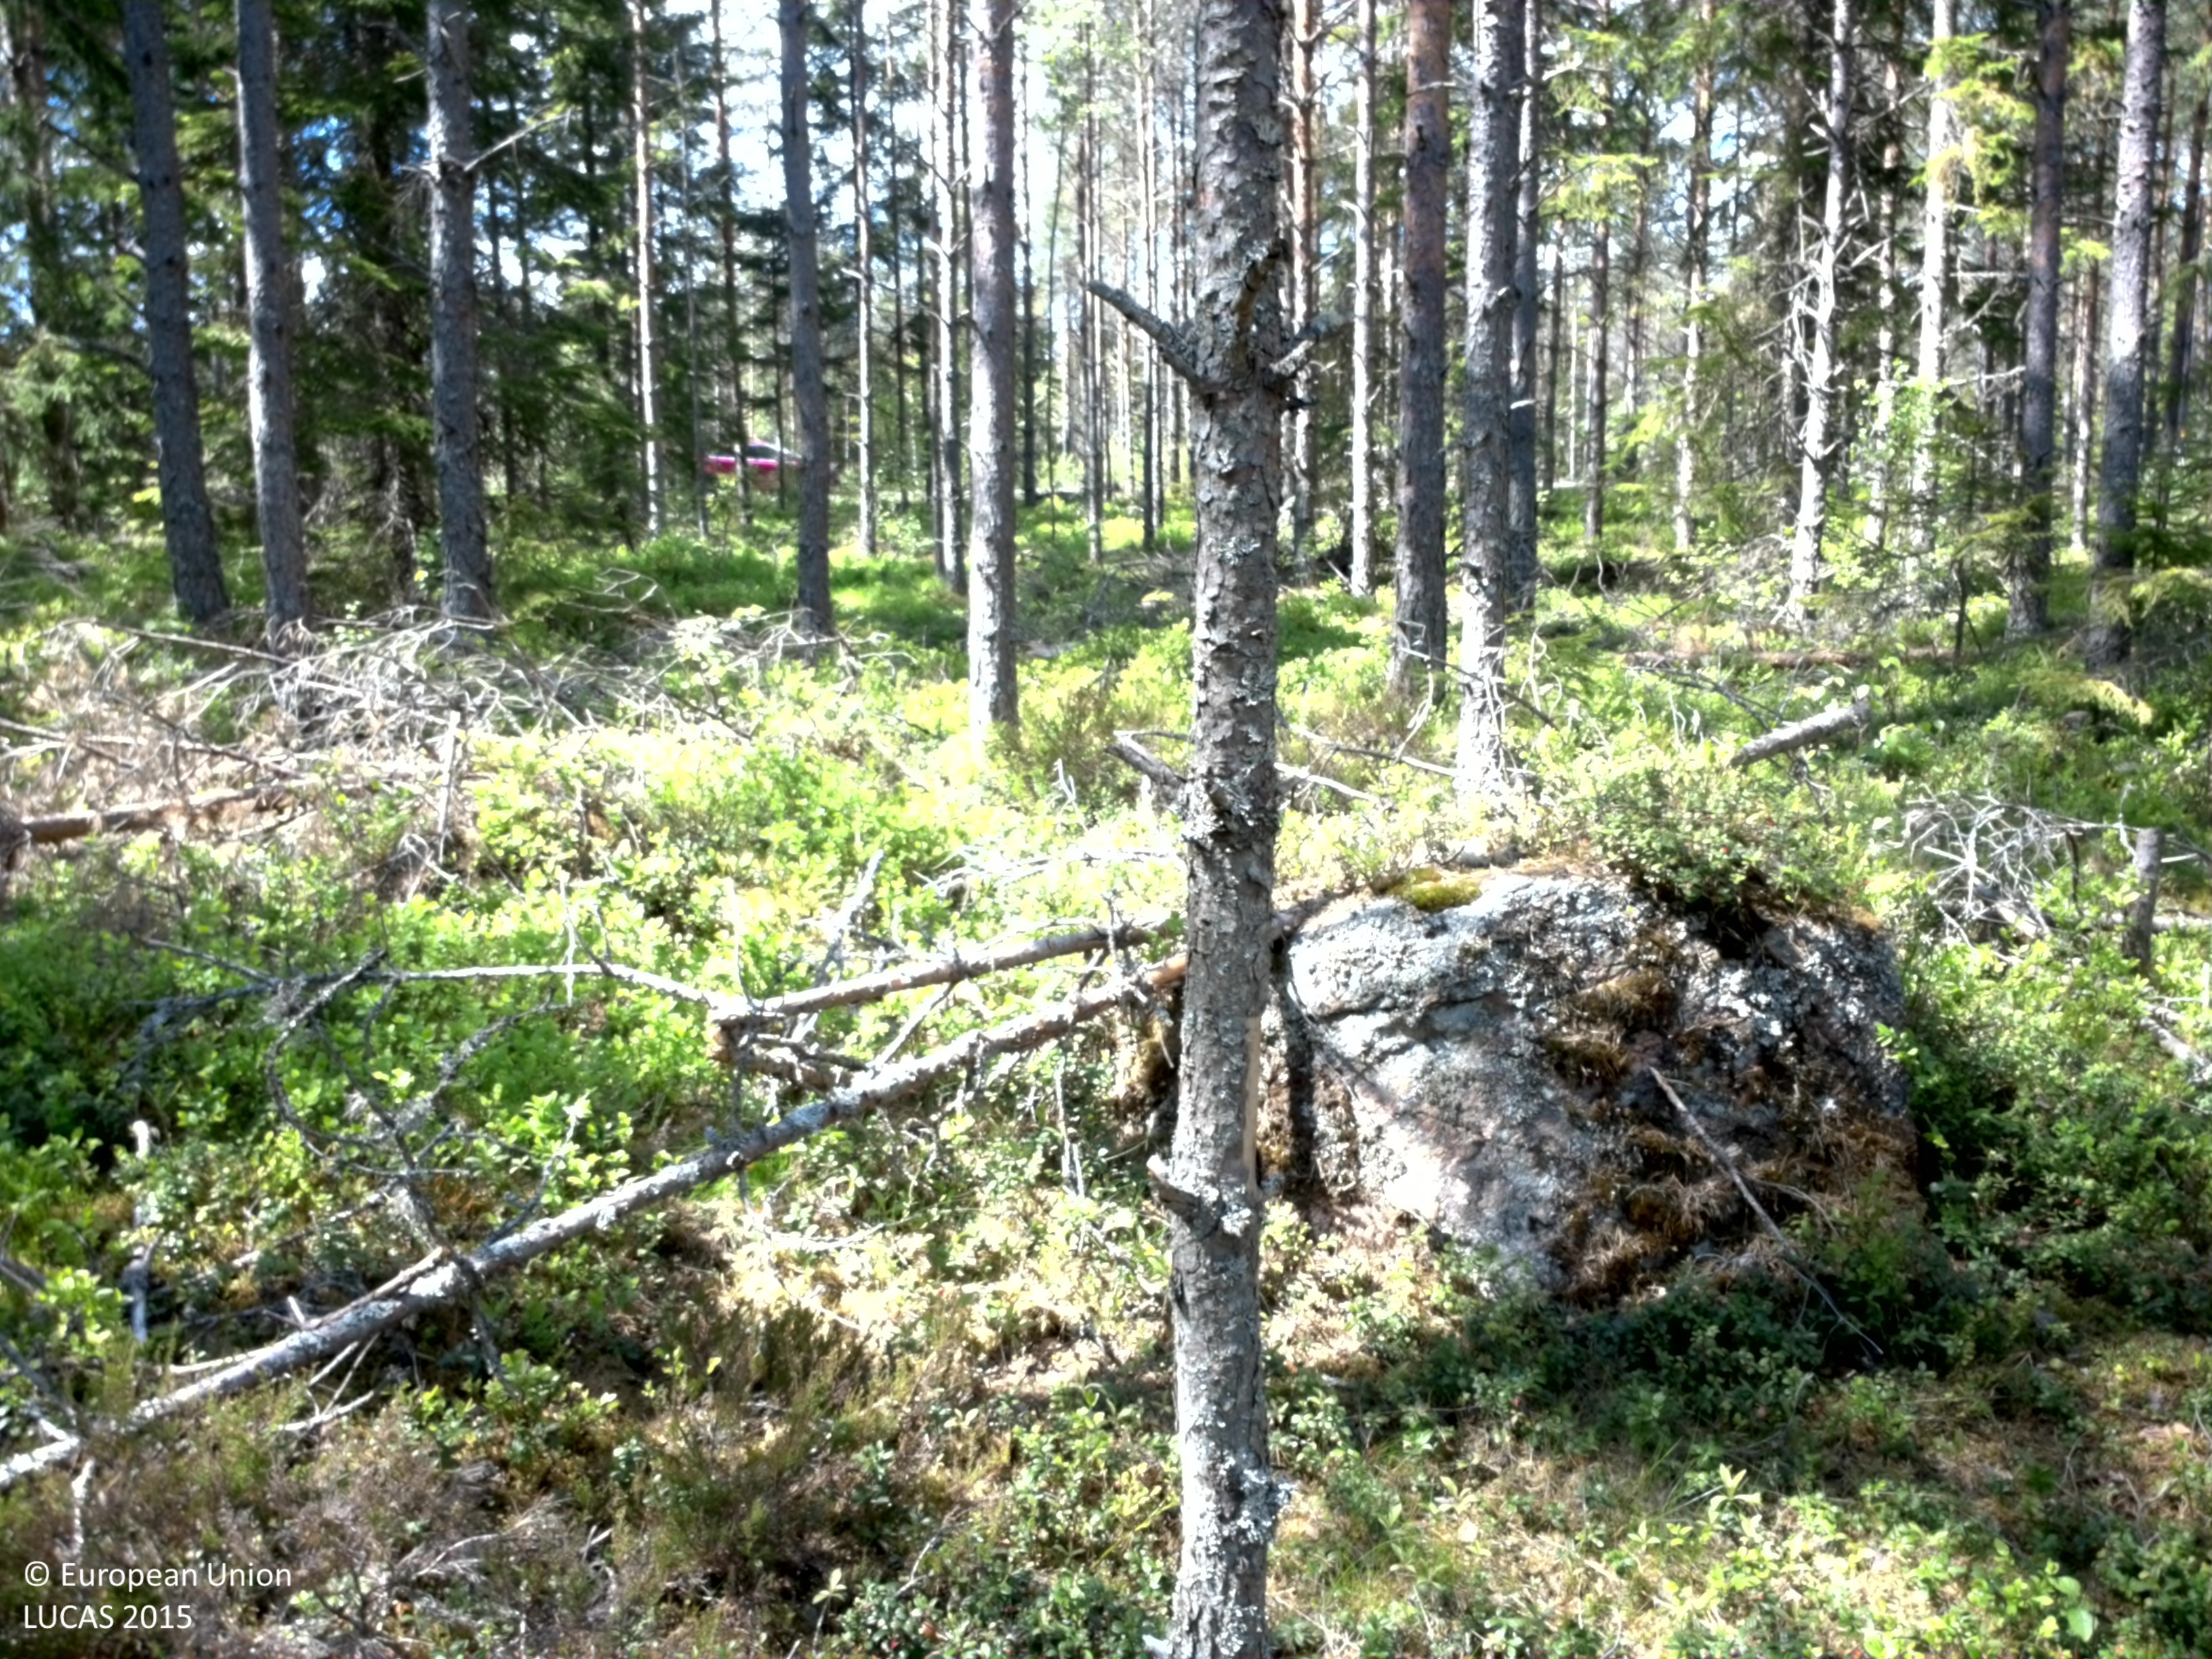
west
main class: Woodland
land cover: Pine dominated coniferous woodland
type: boreal forest
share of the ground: > 75 %
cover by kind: coniferous forest trees 80 %, shrubs 10 %, lichens and mosses 10 %
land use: Forestry
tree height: > 5 m
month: June
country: SE
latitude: 59.3679
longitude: 12.4046
